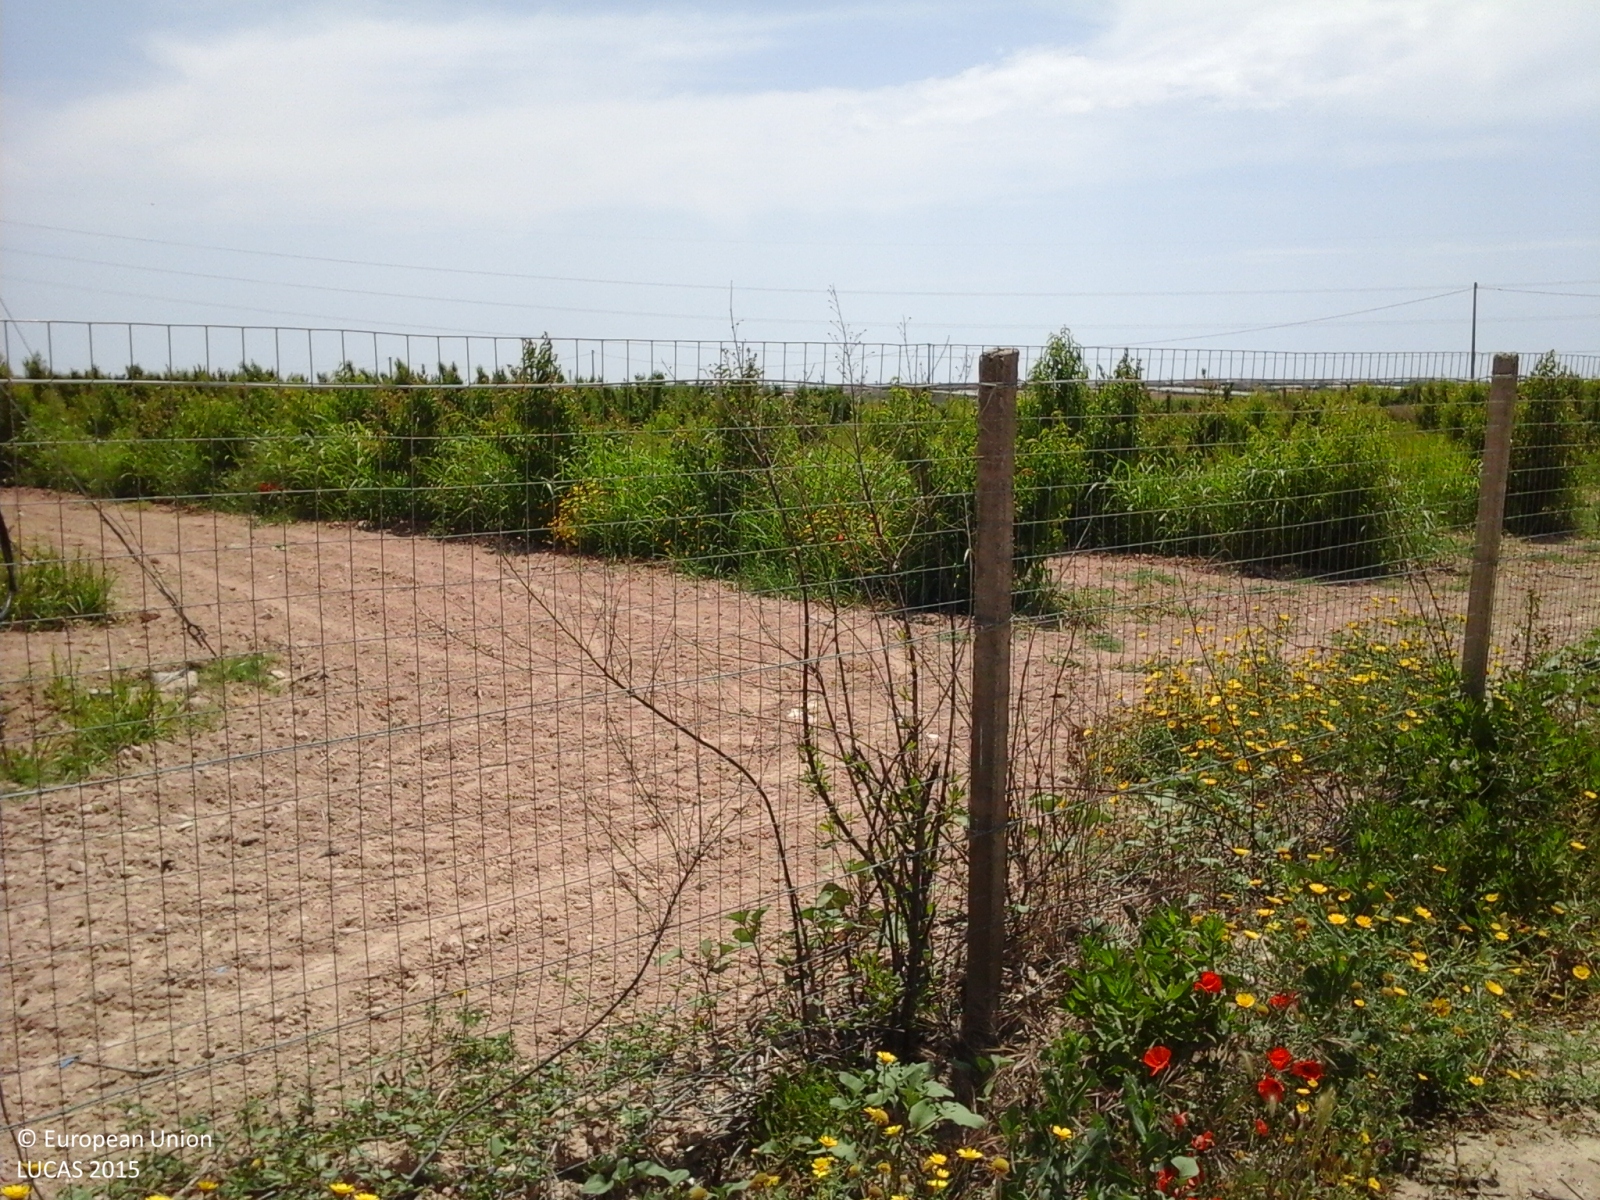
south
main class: Cropland
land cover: Vineyards
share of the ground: 25 - 50 %
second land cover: Spontaneously vegetated surfaces
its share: > 75 %
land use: Agriculture (excluding fallow land and kitchen gardens)
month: May
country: IT
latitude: 37.1104
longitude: 14.5671
